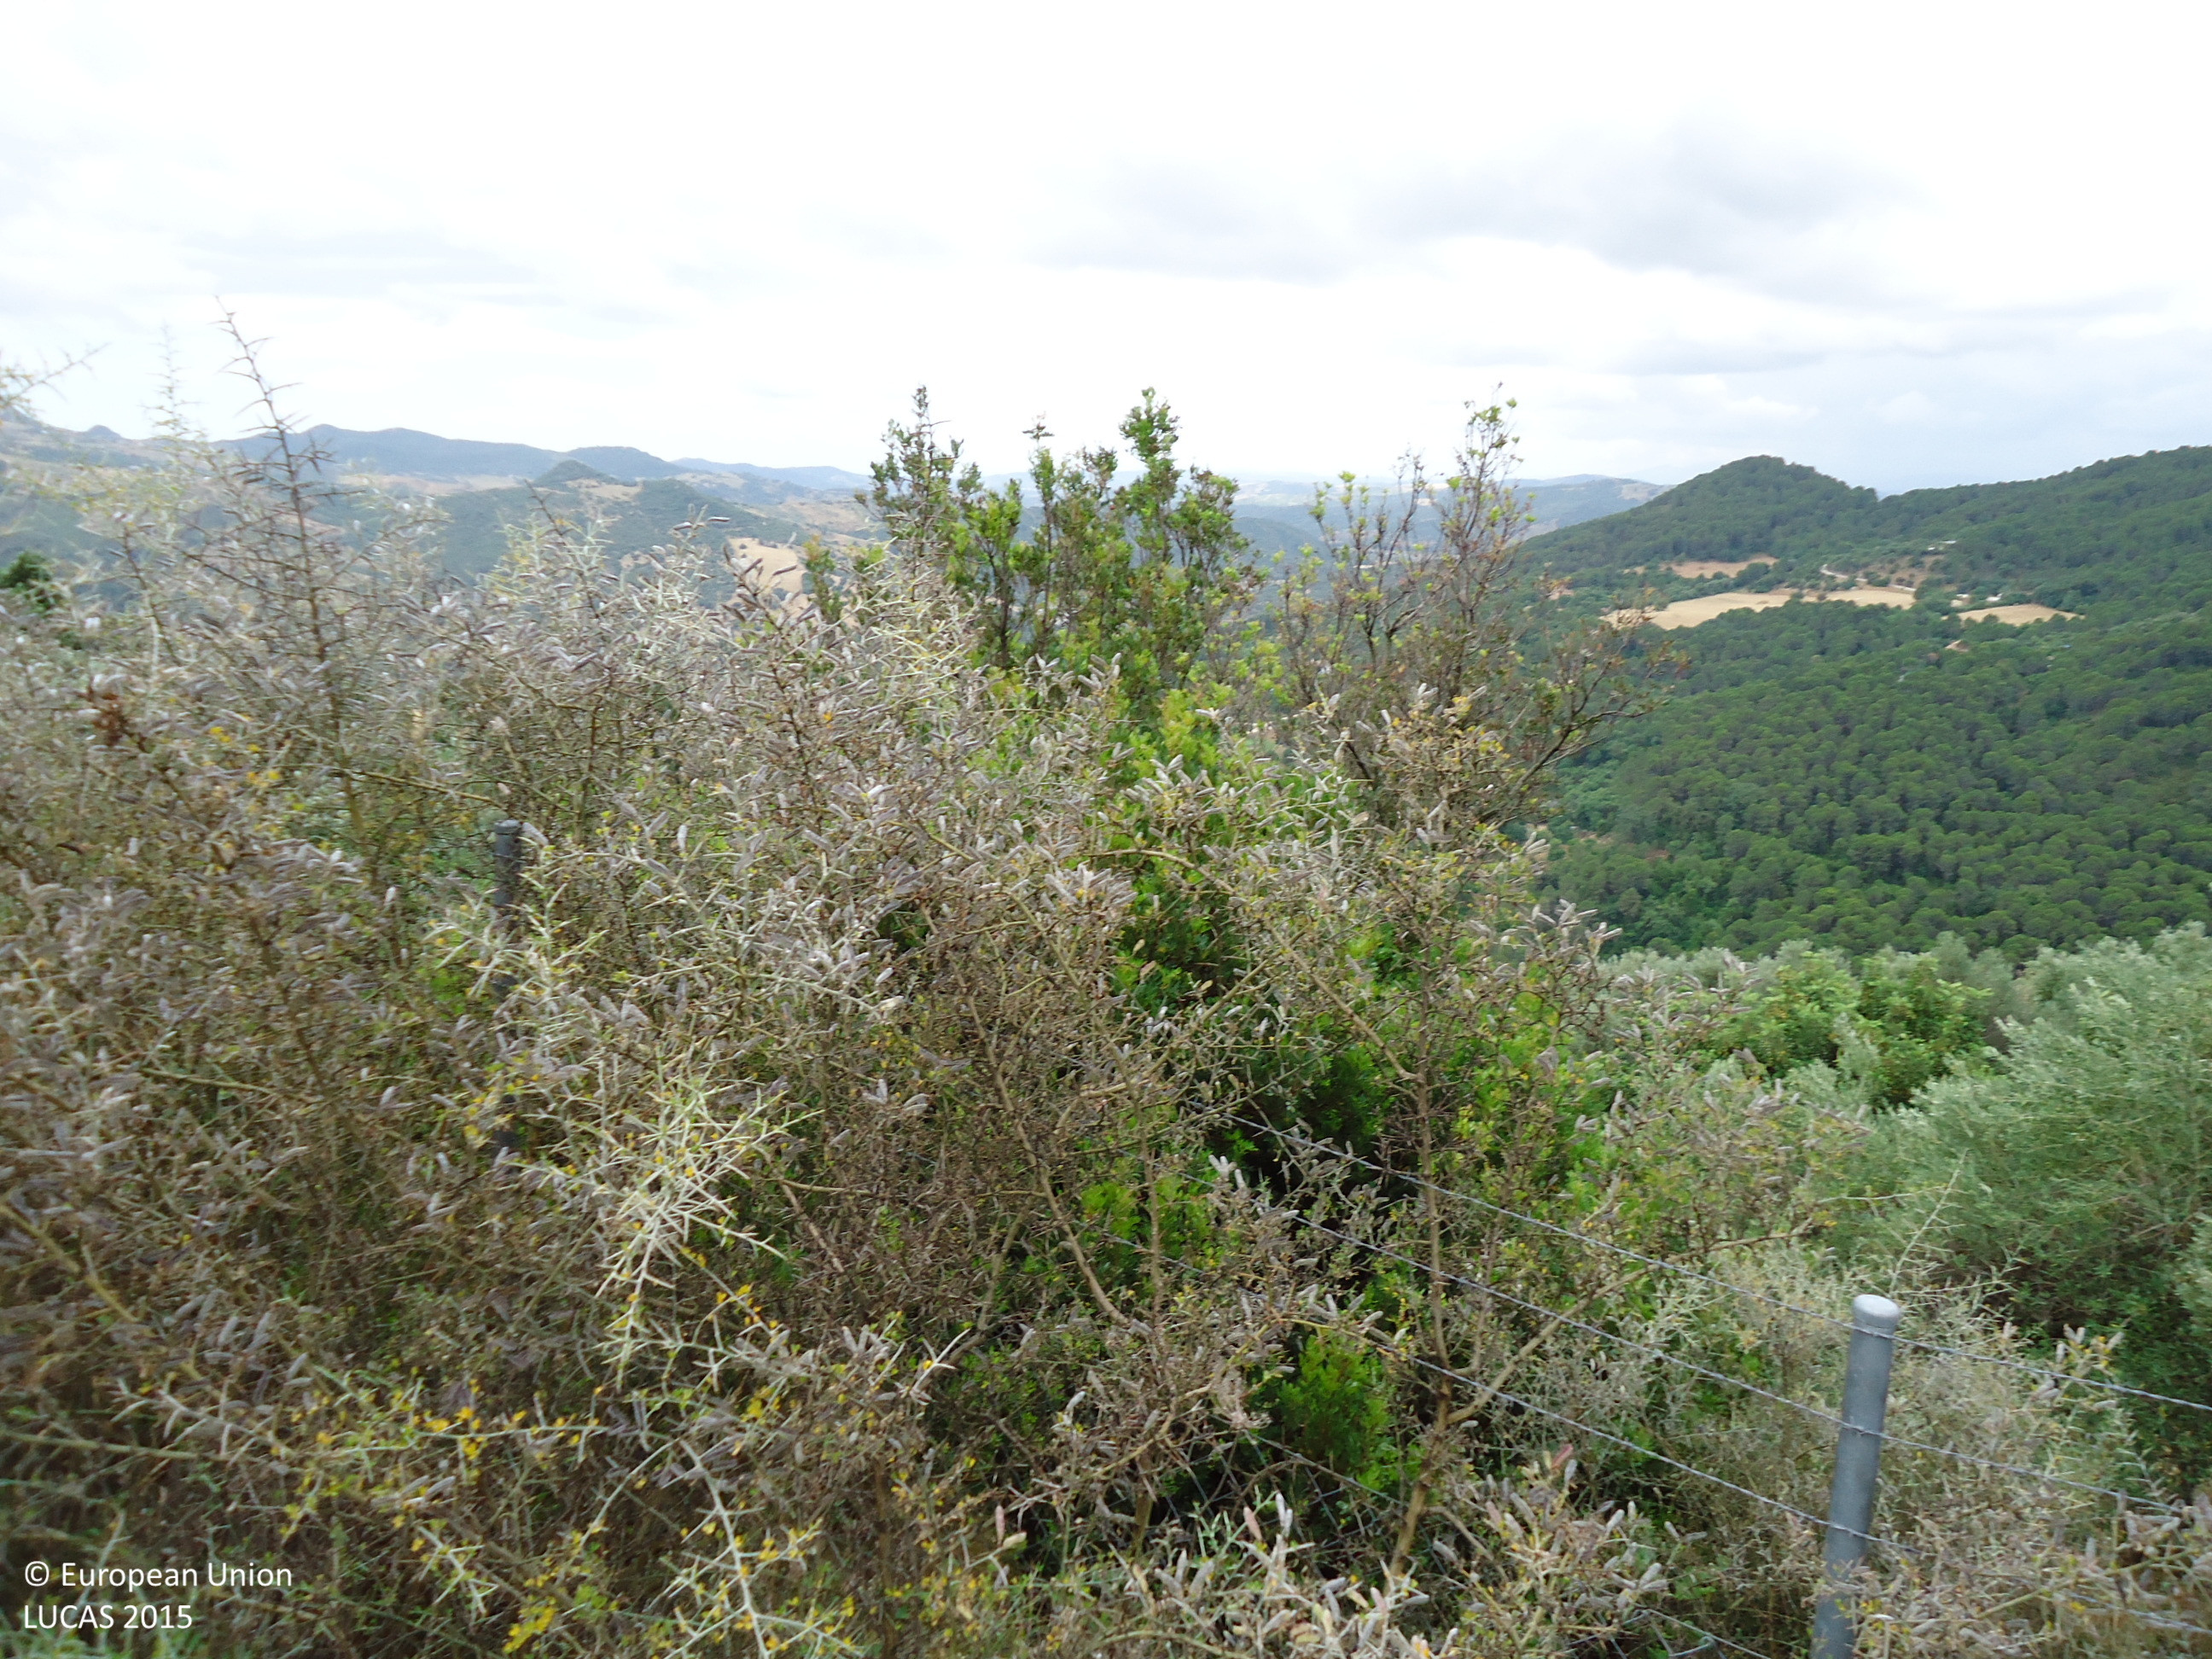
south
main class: Woodland
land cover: Broadleaved woodland
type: broadleaved evergreen forest
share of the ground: 25 - 50 %
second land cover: Grassland without tree/shrub cover
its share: > 75 %
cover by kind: herbaceous plants 55 %, broadleaved forest trees 45 %
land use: Forestry
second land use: Agriculture (excluding fallow land and kitchen gardens)
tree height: > 5 m
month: June
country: ES
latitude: 36.4974
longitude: -5.3248
